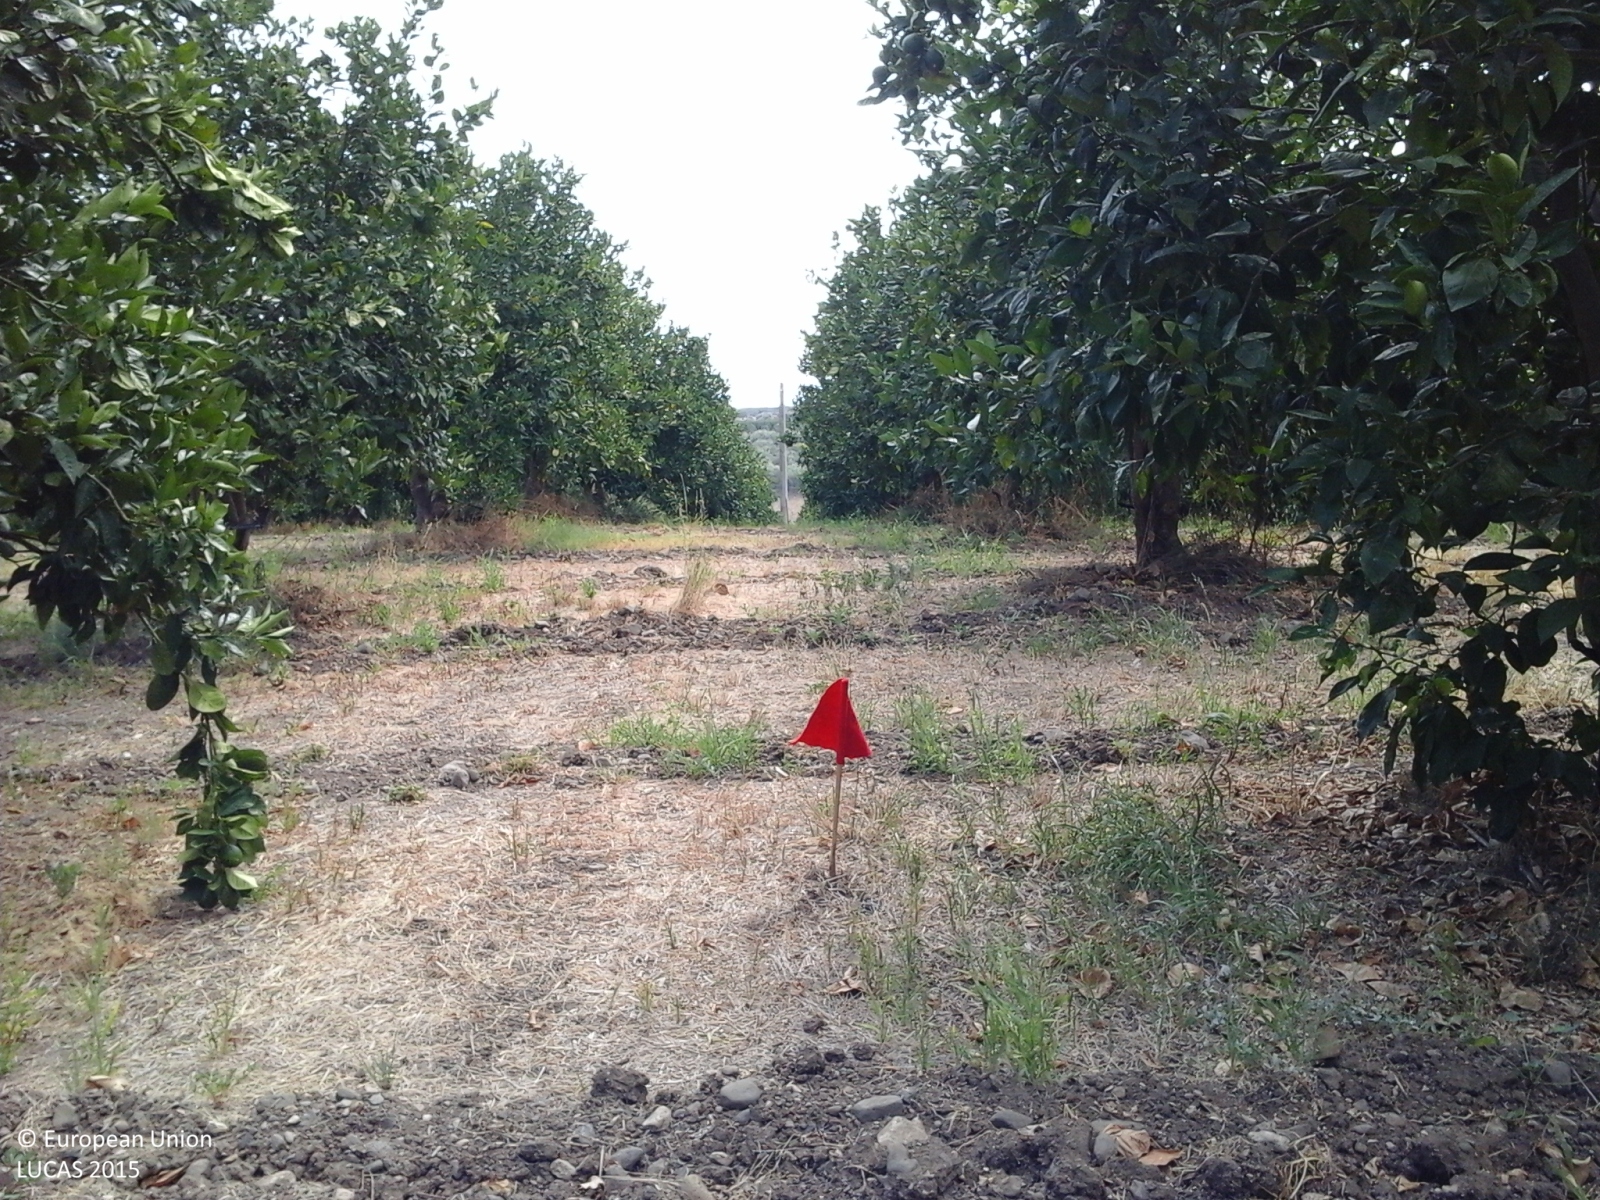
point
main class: Cropland
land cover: Oranges
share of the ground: > 75 %
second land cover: Spontaneously vegetated surfaces
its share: > 75 %
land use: Agriculture (excluding fallow land and kitchen gardens)
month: August
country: IT
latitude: 37.2953
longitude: 14.8708
